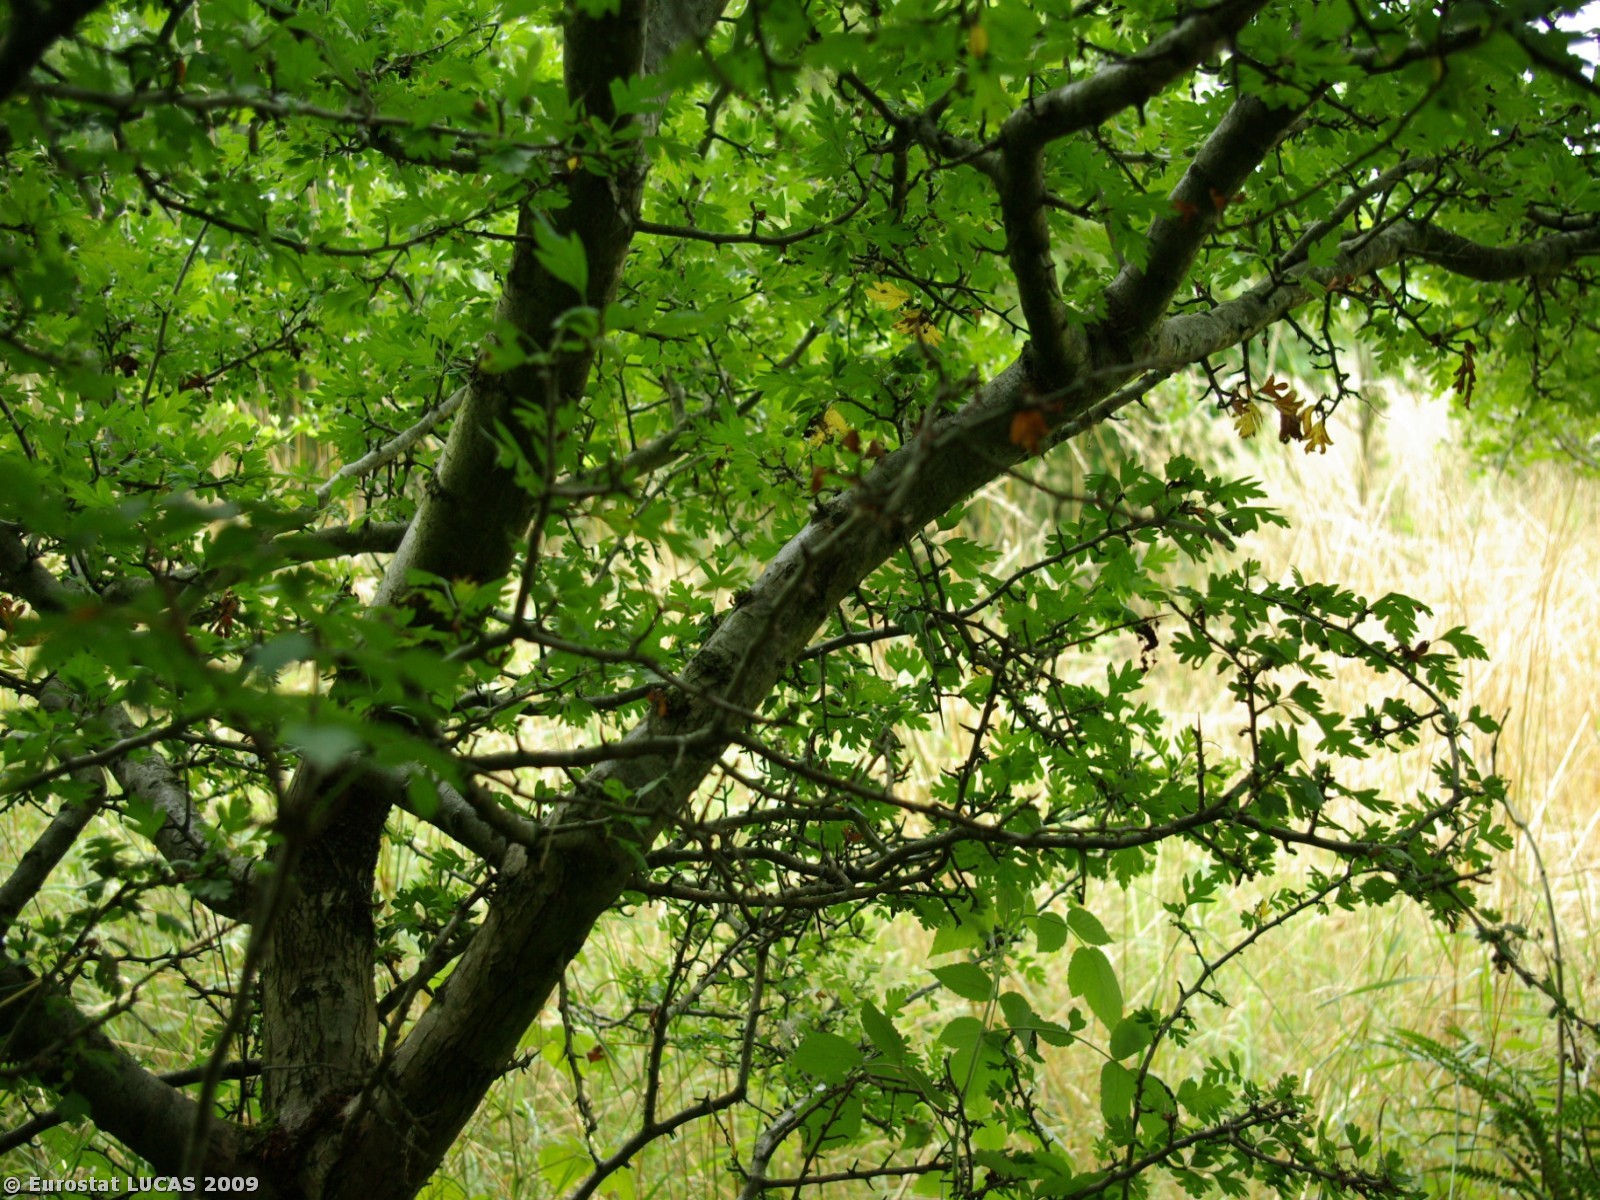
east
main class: Woodland
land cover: Broadleaved woodland
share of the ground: 50 - 75 %
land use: Unused
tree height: > 5 m
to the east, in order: Broadleaved woodland; Spontaneously vegetated surfaces; Broadleaved woodland; Spontaneously vegetated surfaces; Coniferous woodland; Shrubland with sparse tree cover; Grass margins; Maize
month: July
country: DK
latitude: 55.2331
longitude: 9.2930
